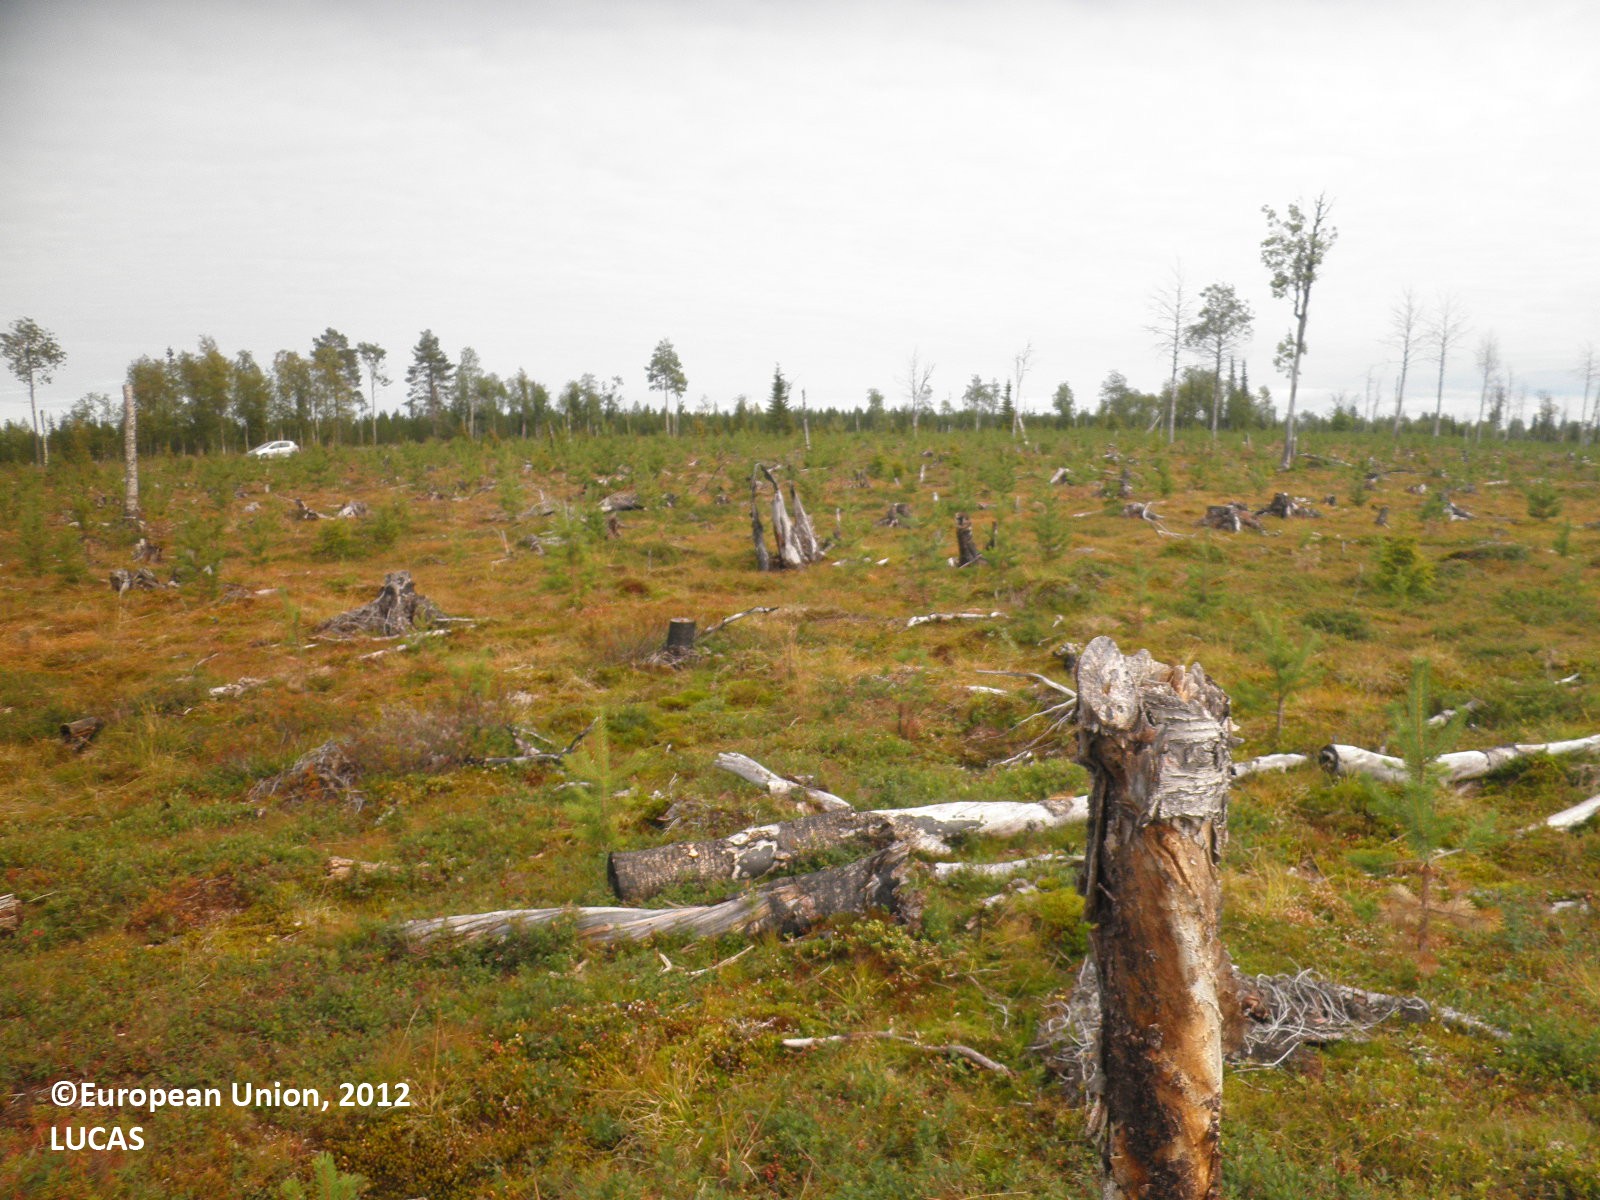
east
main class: Grassland
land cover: Grassland with sparse tree/shrub cover
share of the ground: > 75 %
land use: Forestry
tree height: < 5 m
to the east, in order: Grassland with sparse tree/shrub cover; Pine dominated coniferous woodland; Ditches and canals; Tracks; Ditches and canals; Shrubland with sparse tree cover; Grassland with sparse tree/shrub cover; Spruce dominated coniferous woodland
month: August
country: FI
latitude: 67.7609
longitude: 26.3288
